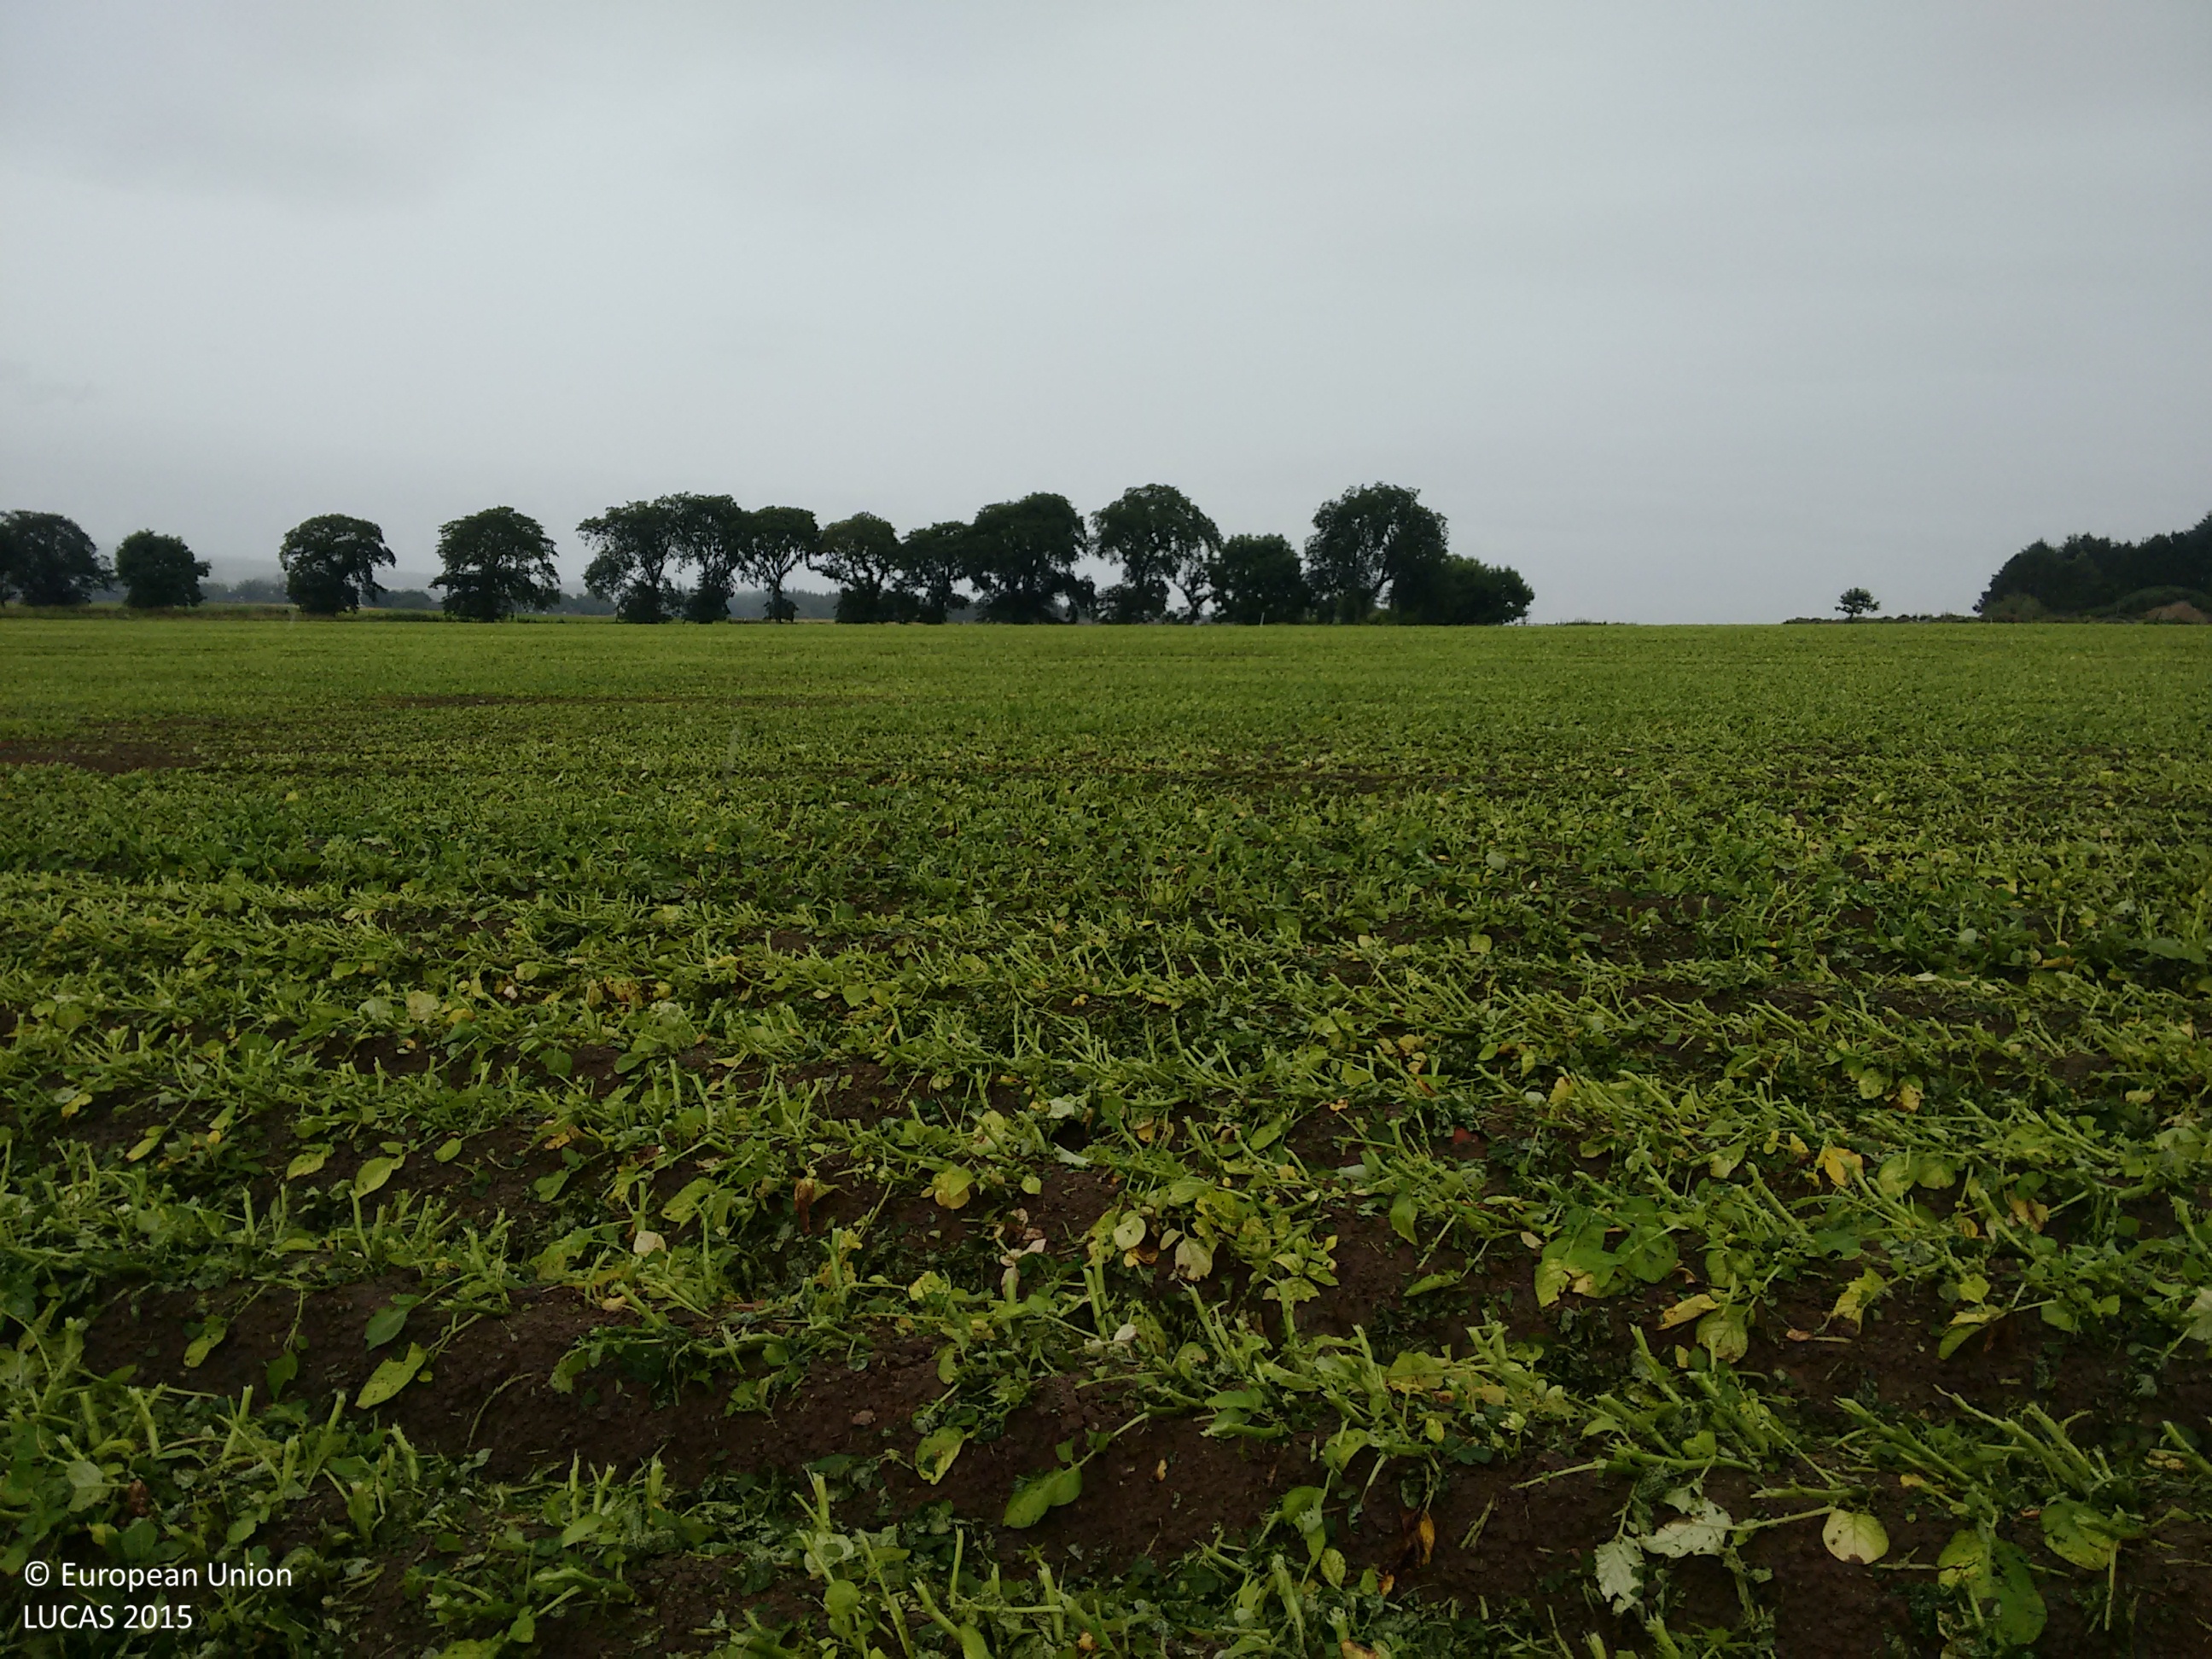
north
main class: Cropland
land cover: Potatoes
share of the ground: 10 - 25 %
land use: Agriculture (excluding fallow land and kitchen gardens)
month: August
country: GB
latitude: 57.7199
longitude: -3.9965
